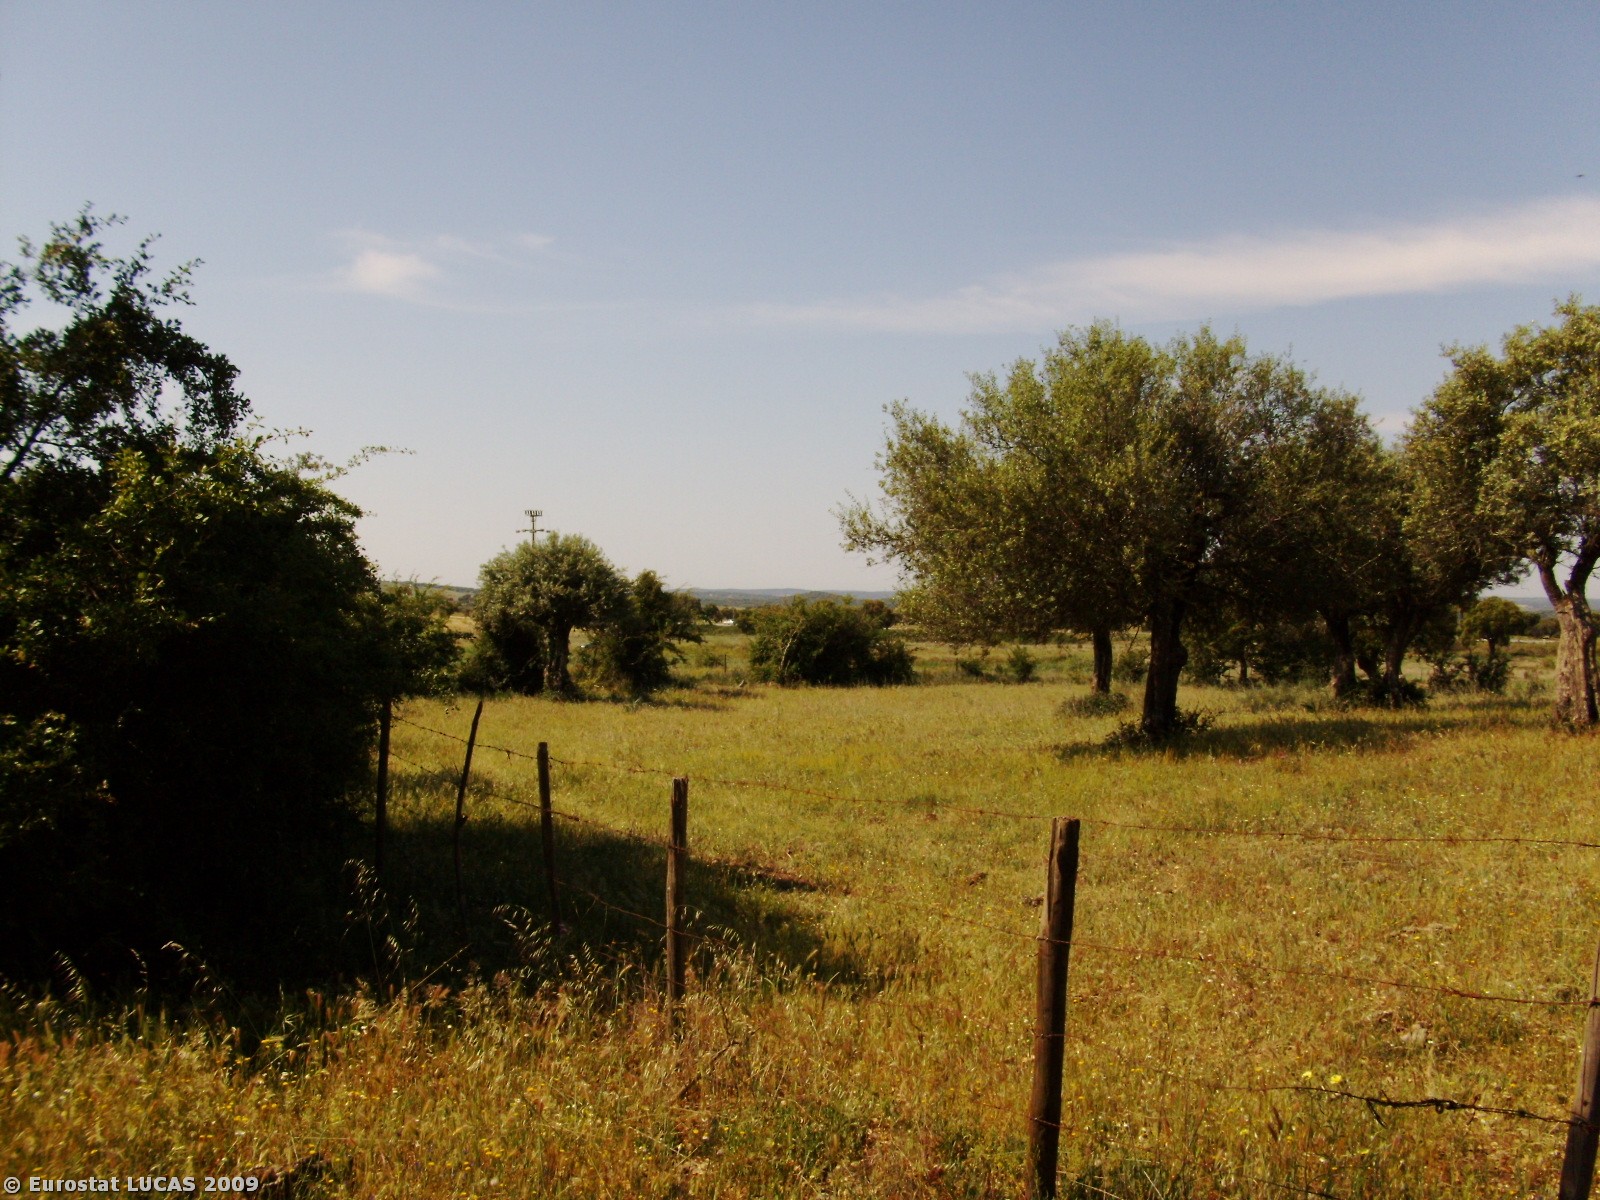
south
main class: Woodland
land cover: Broadleaved woodland
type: broadleaved evergreen forest
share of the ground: 25 - 50 %
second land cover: Grassland with sparse tree/shrub cover
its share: 50 - 75 %
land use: Forestry
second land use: Agriculture (excluding fallow land and kitchen gardens)
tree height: > 5 m
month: May
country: PT
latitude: 39.2685
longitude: -7.4150
